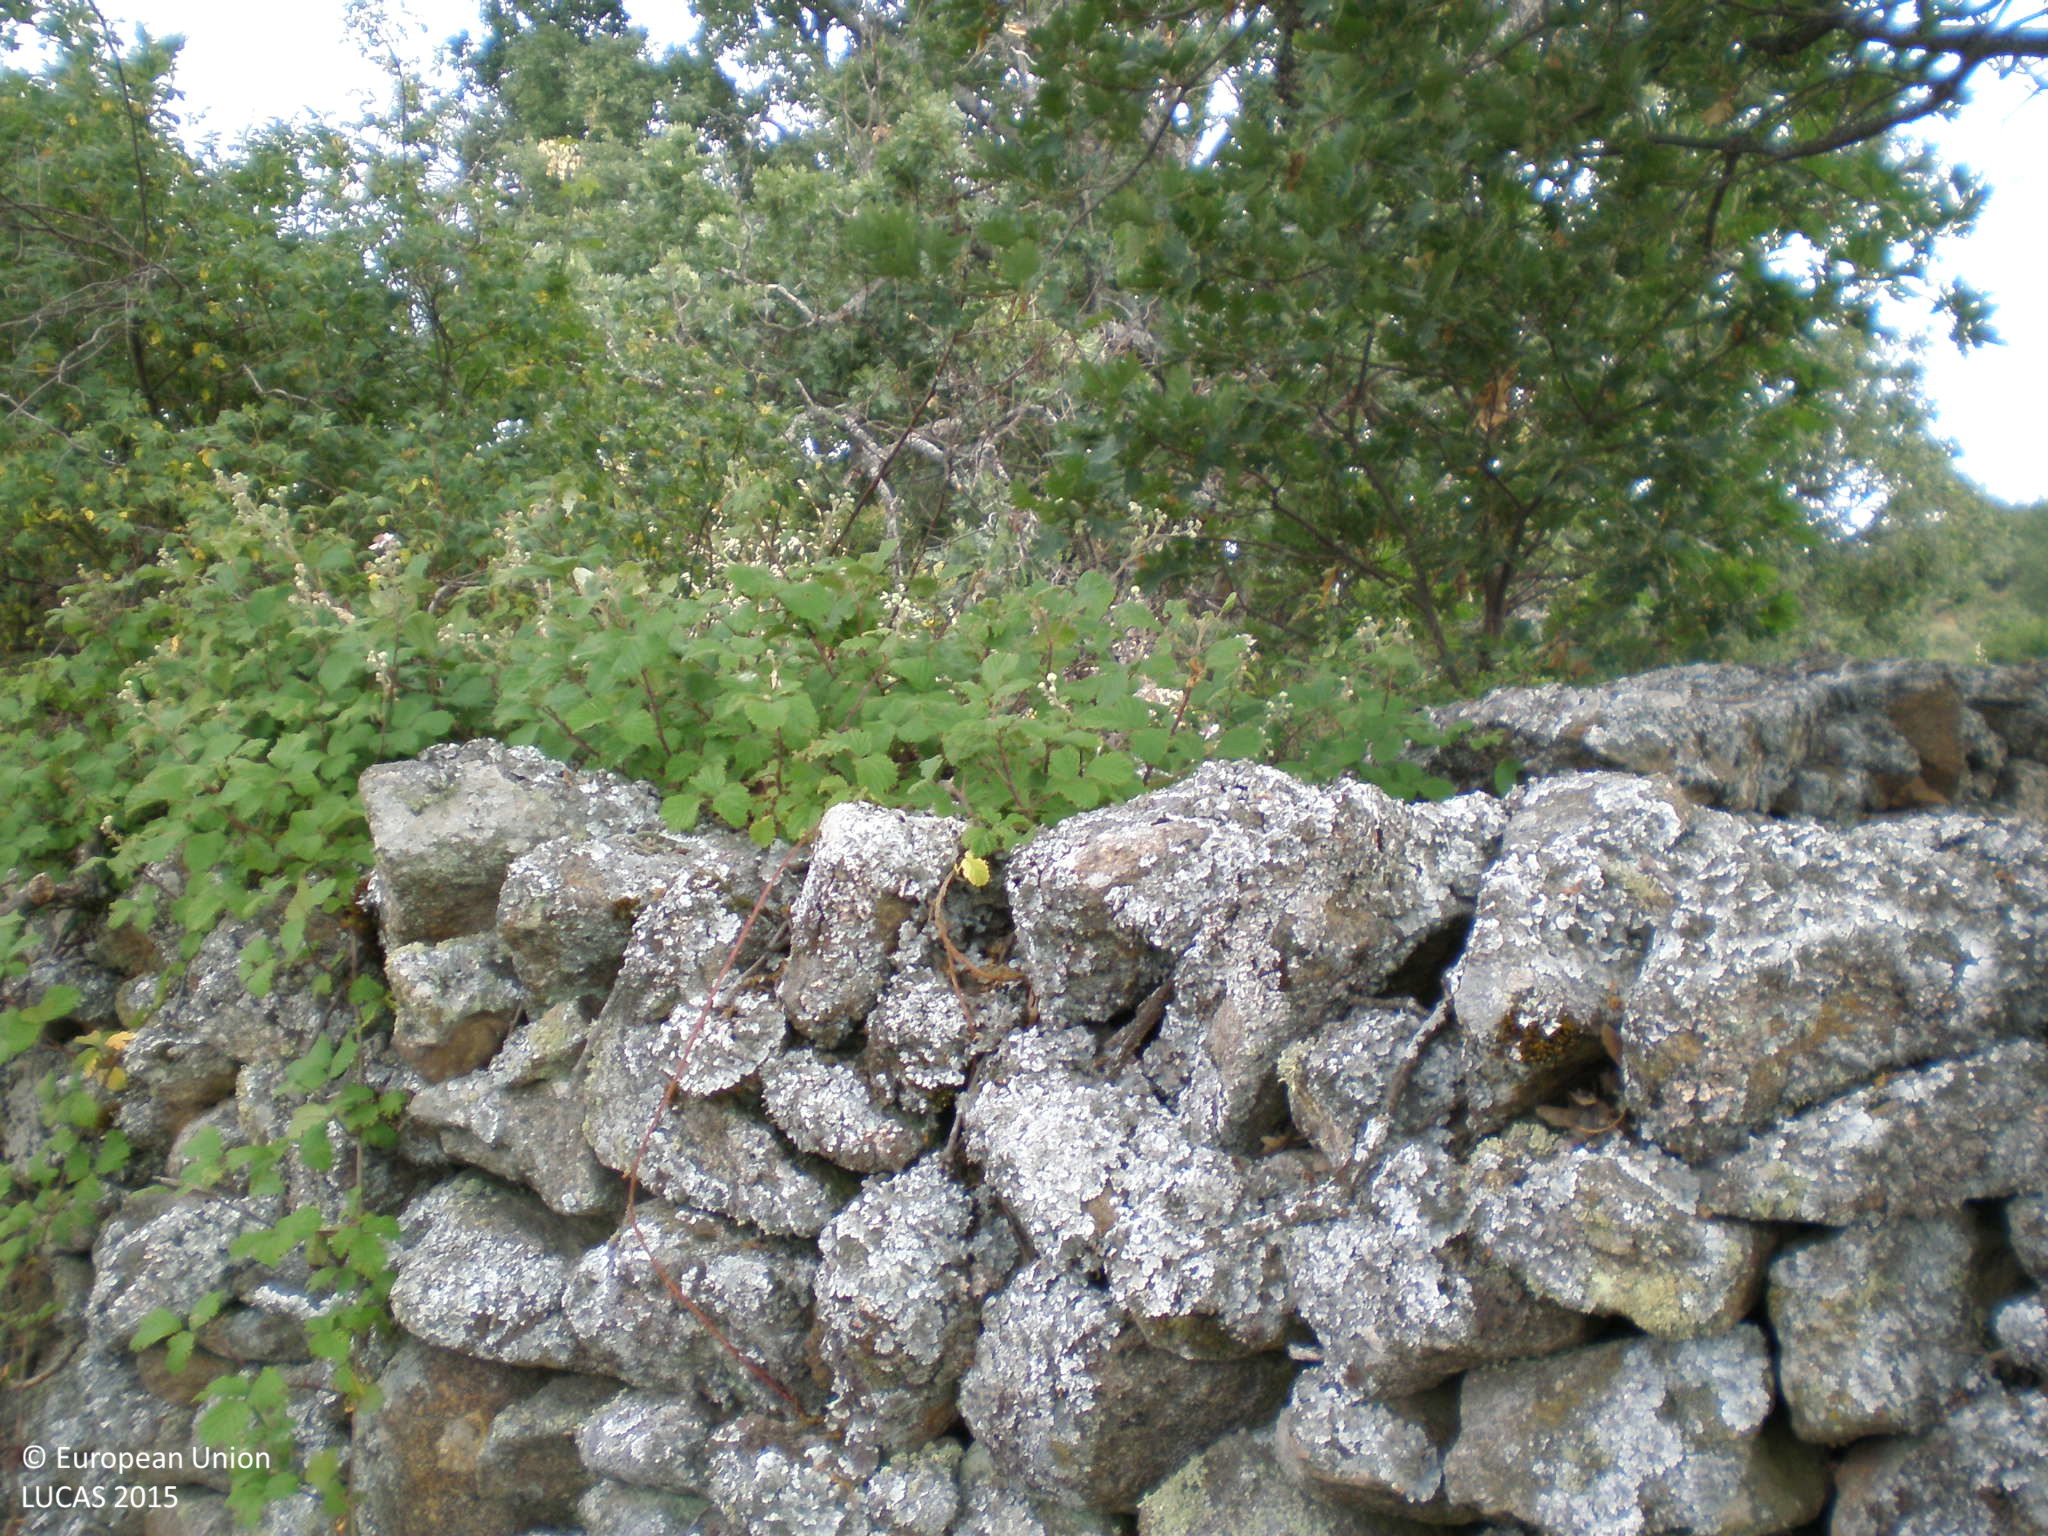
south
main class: Woodland
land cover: Broadleaved woodland
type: thermophilous deciduous forest
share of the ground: 10 - 25 %
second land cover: Grassland without tree/shrub cover
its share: > 75 %
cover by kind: herbaceous plants 85 %, broadleaved forest trees 15 %
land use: Forestry
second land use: Agriculture (excluding fallow land and kitchen gardens)
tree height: > 5 m
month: June
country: ES
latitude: 40.3821
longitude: -5.5322
